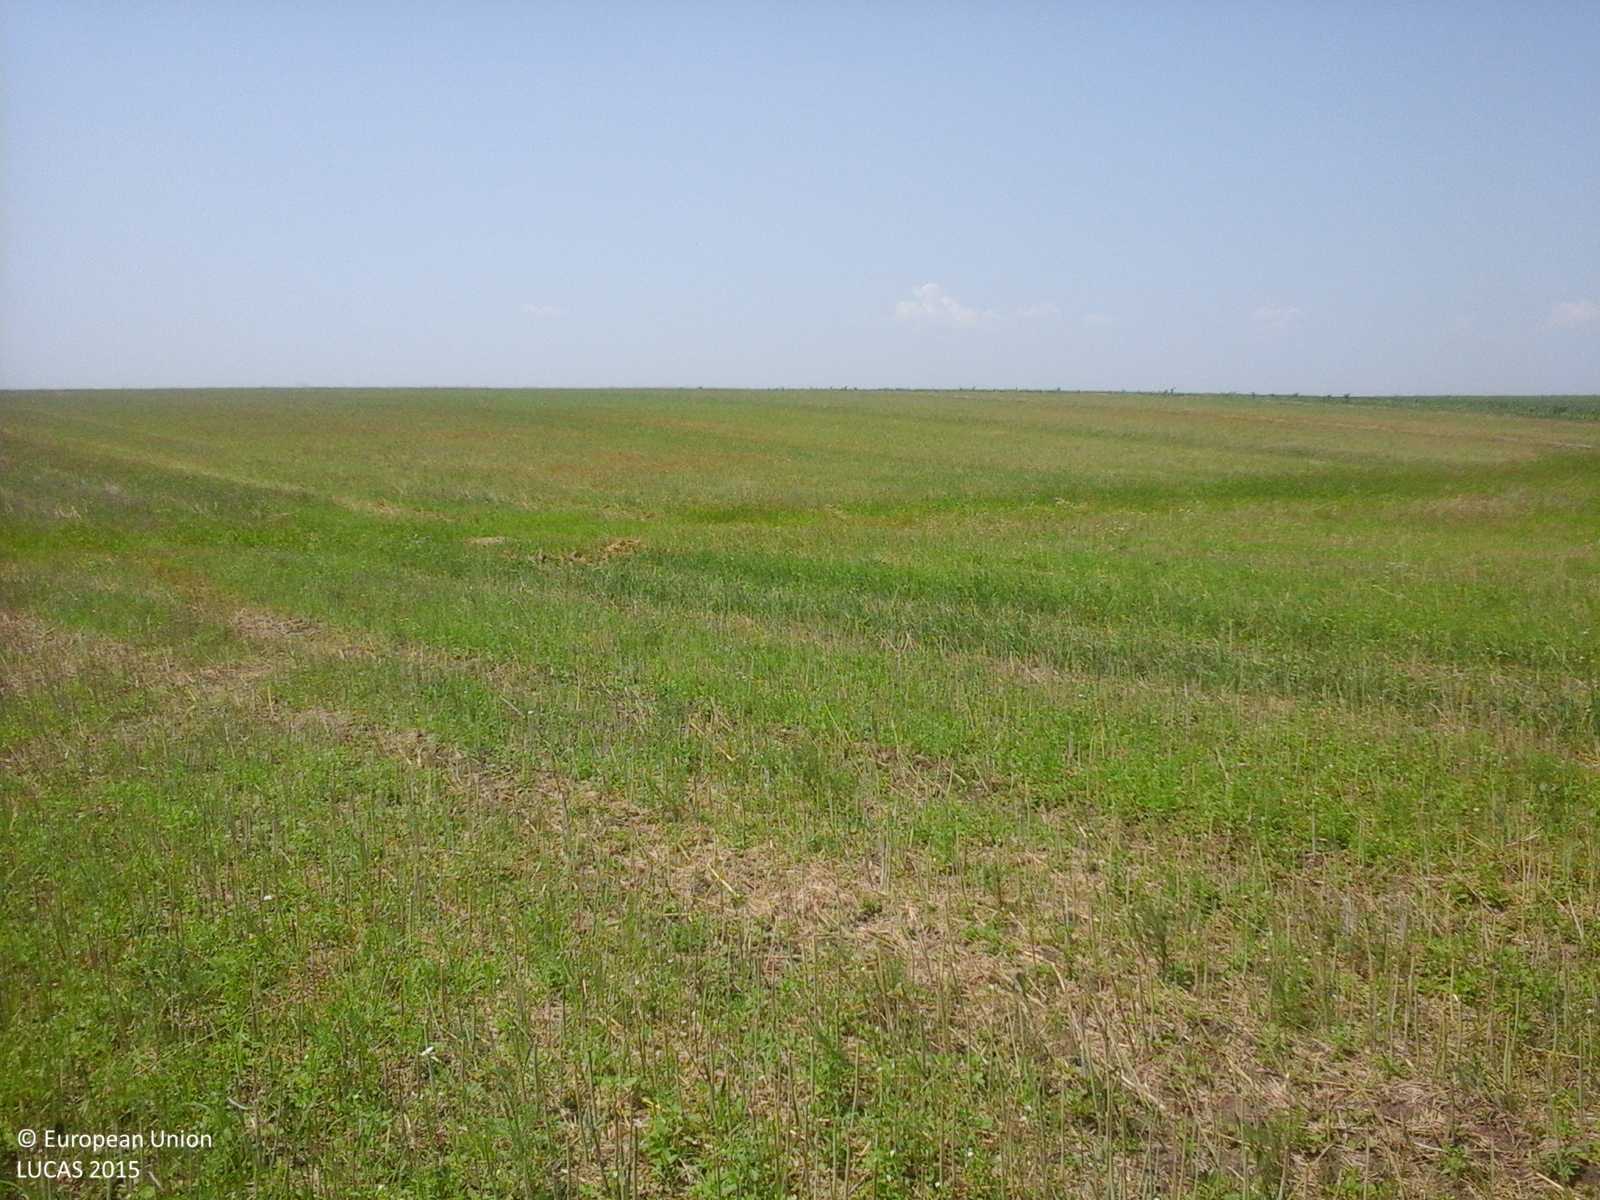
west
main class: Cropland
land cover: Rape and turnip rape
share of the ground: 10 - 25 %
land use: Agriculture (excluding fallow land and kitchen gardens)
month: July
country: RO
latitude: 44.4835
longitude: 24.8516
